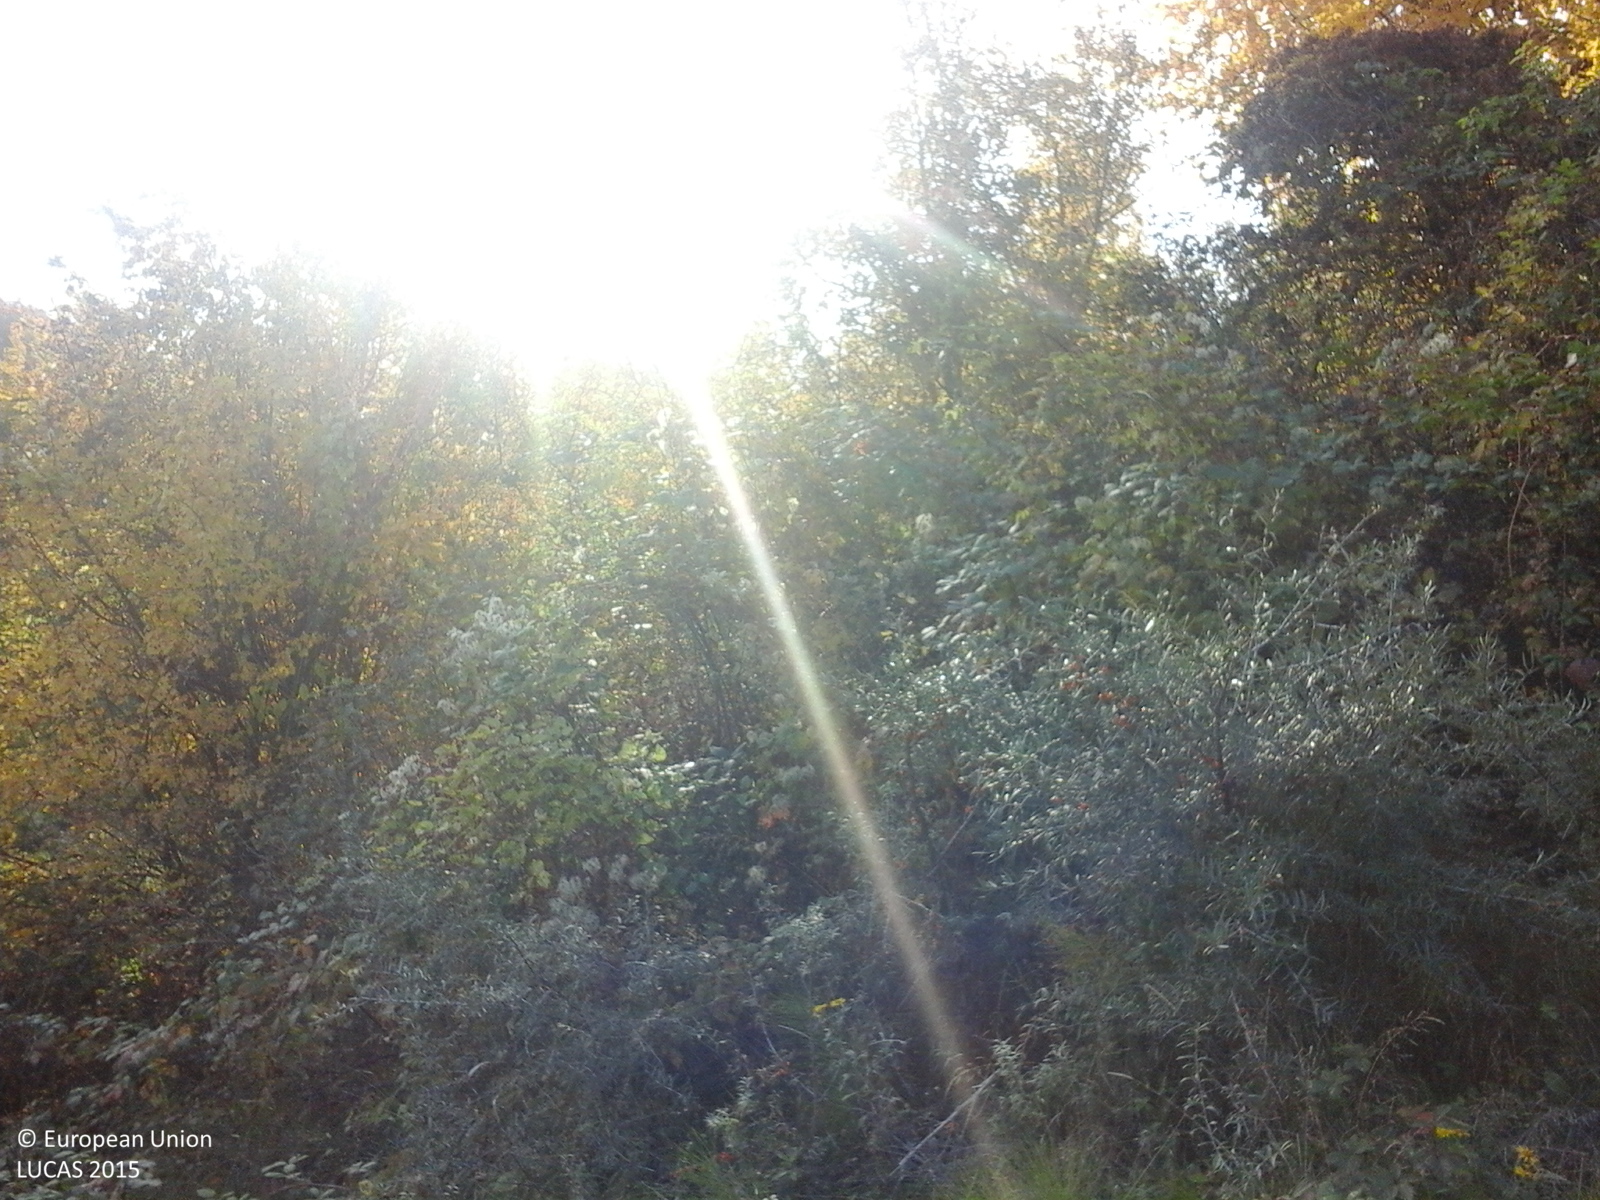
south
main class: Grassland
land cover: Spontaneously vegetated surfaces
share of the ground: > 75 %
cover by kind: herbaceous plants 100 %
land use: Agriculture (excluding fallow land and kitchen gardens)
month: October
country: RO
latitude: 45.7632
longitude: 26.9185
